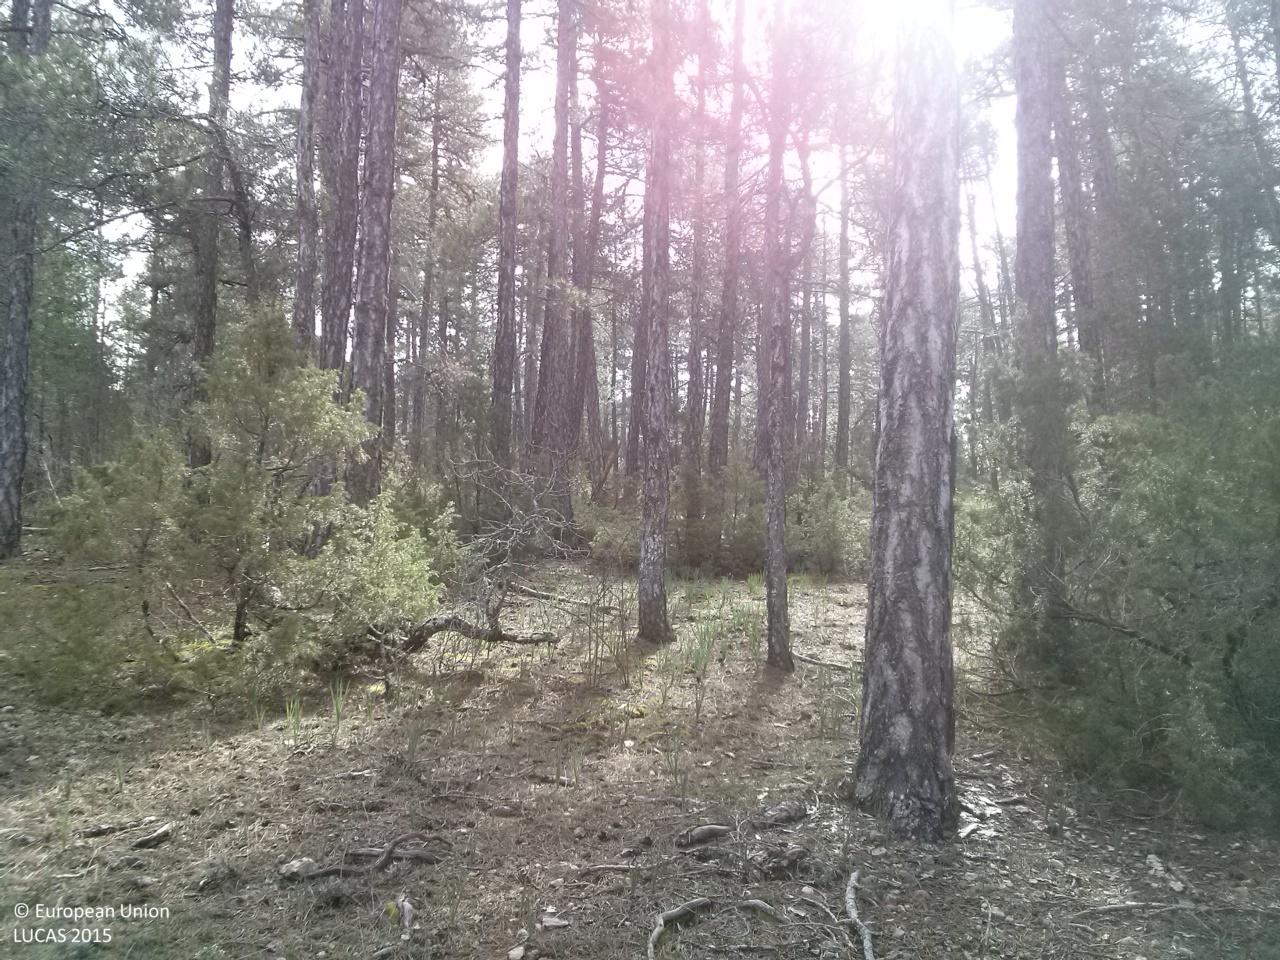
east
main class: Woodland
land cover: Pine dominated coniferous woodland
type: coniferous forest of the mediterranean region
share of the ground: 50 - 75 %
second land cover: Grassland without tree/shrub cover
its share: 10 - 25 %
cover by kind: coniferous forest trees 70 %, herbaceous plants 25 %, consolidated bare surface 5 %
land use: Forestry
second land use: Agriculture (excluding fallow land and kitchen gardens)
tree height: > 5 m
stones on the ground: 10 - 25 %
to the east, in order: Pine dominated coniferous woodland; Grassland without tree/shrub cover
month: April
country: ES
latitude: 40.2525
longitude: -1.9018
